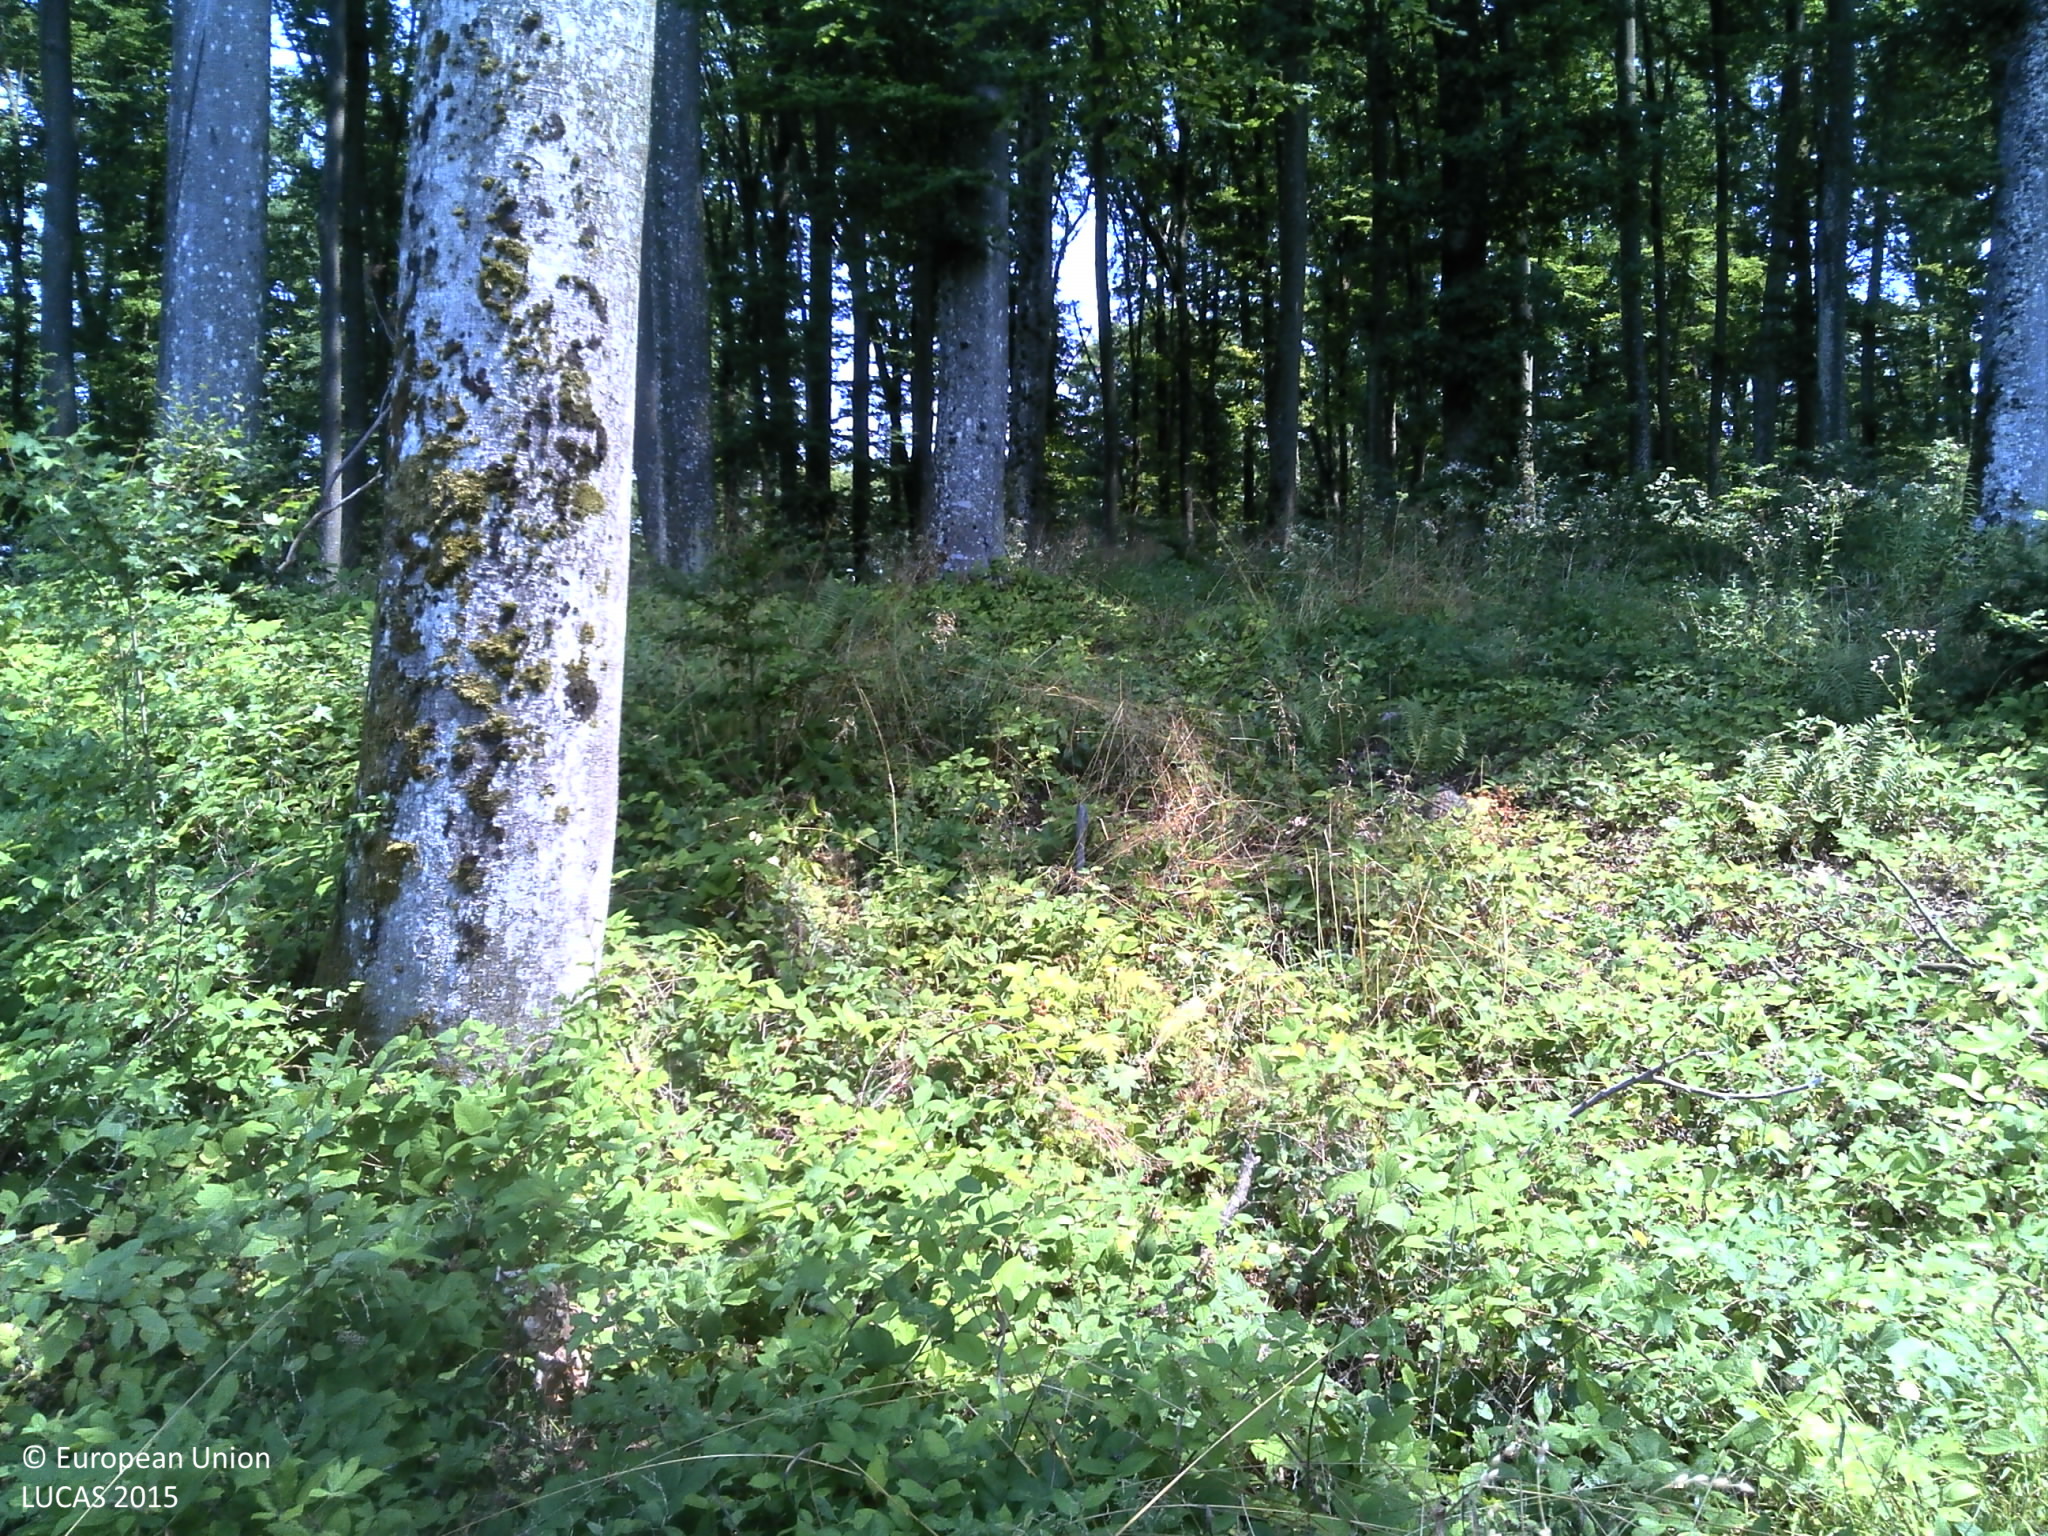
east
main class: Woodland
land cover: Broadleaved woodland
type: beech forest
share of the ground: > 75 %
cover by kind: broadleaved forest trees 100 %
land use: Forestry
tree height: > 5 m
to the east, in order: Broadleaved woodland; Tracks; Spontaneously vegetated surfaces; Broadleaved woodland
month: July
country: HR
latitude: 45.6581
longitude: 17.1748
